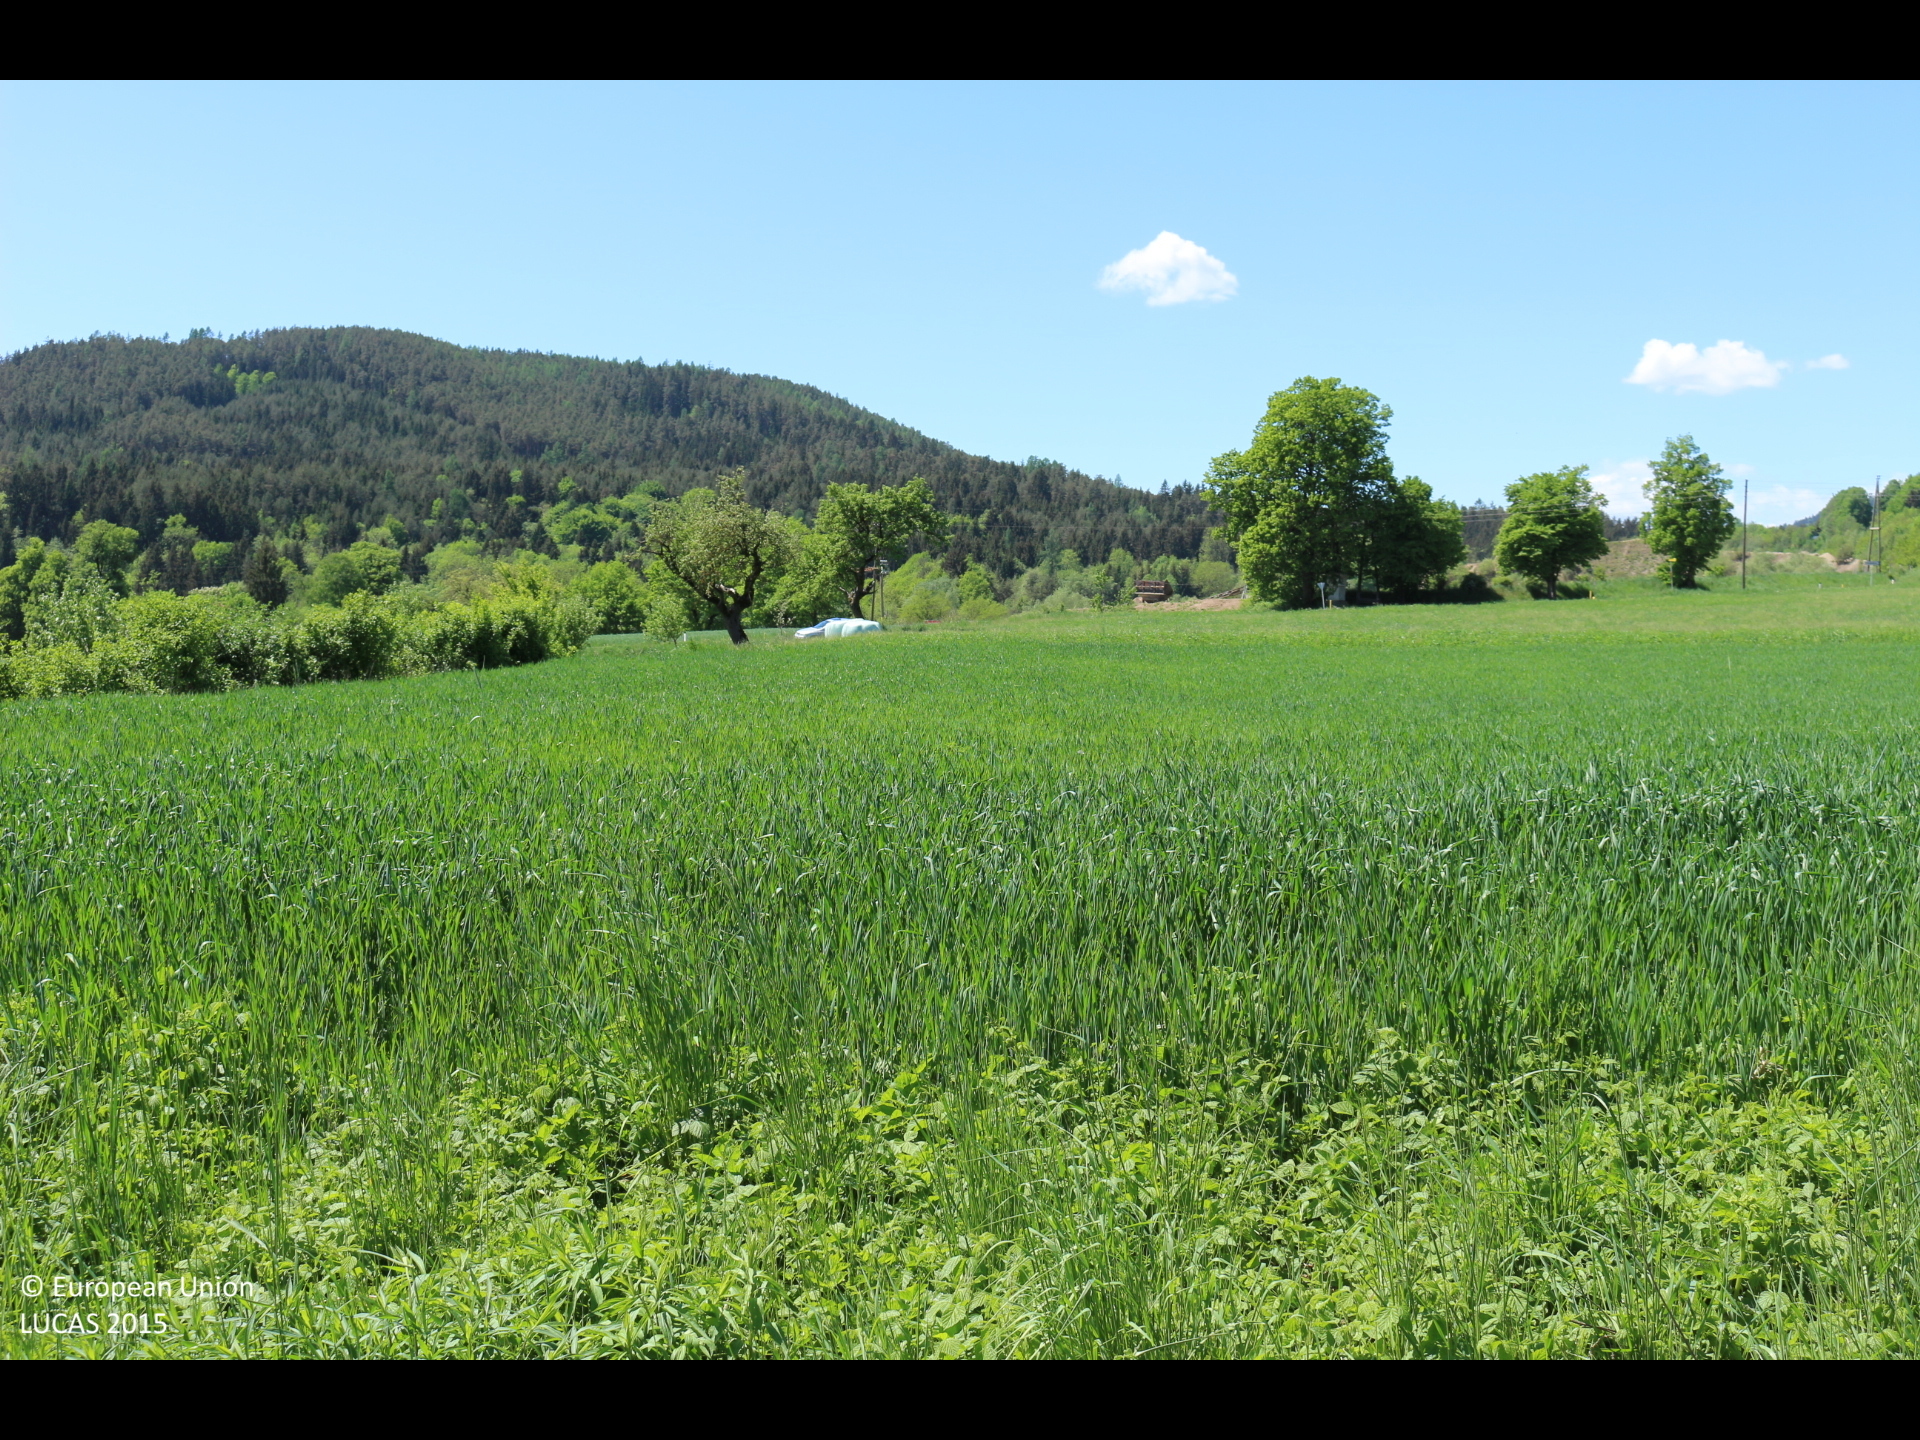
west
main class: Grassland
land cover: Spontaneously vegetated surfaces
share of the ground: > 75 %
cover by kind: herbaceous plants 95 %, shrubs 5 %
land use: Fallow land
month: May
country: AT
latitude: 46.6912
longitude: 14.4566
